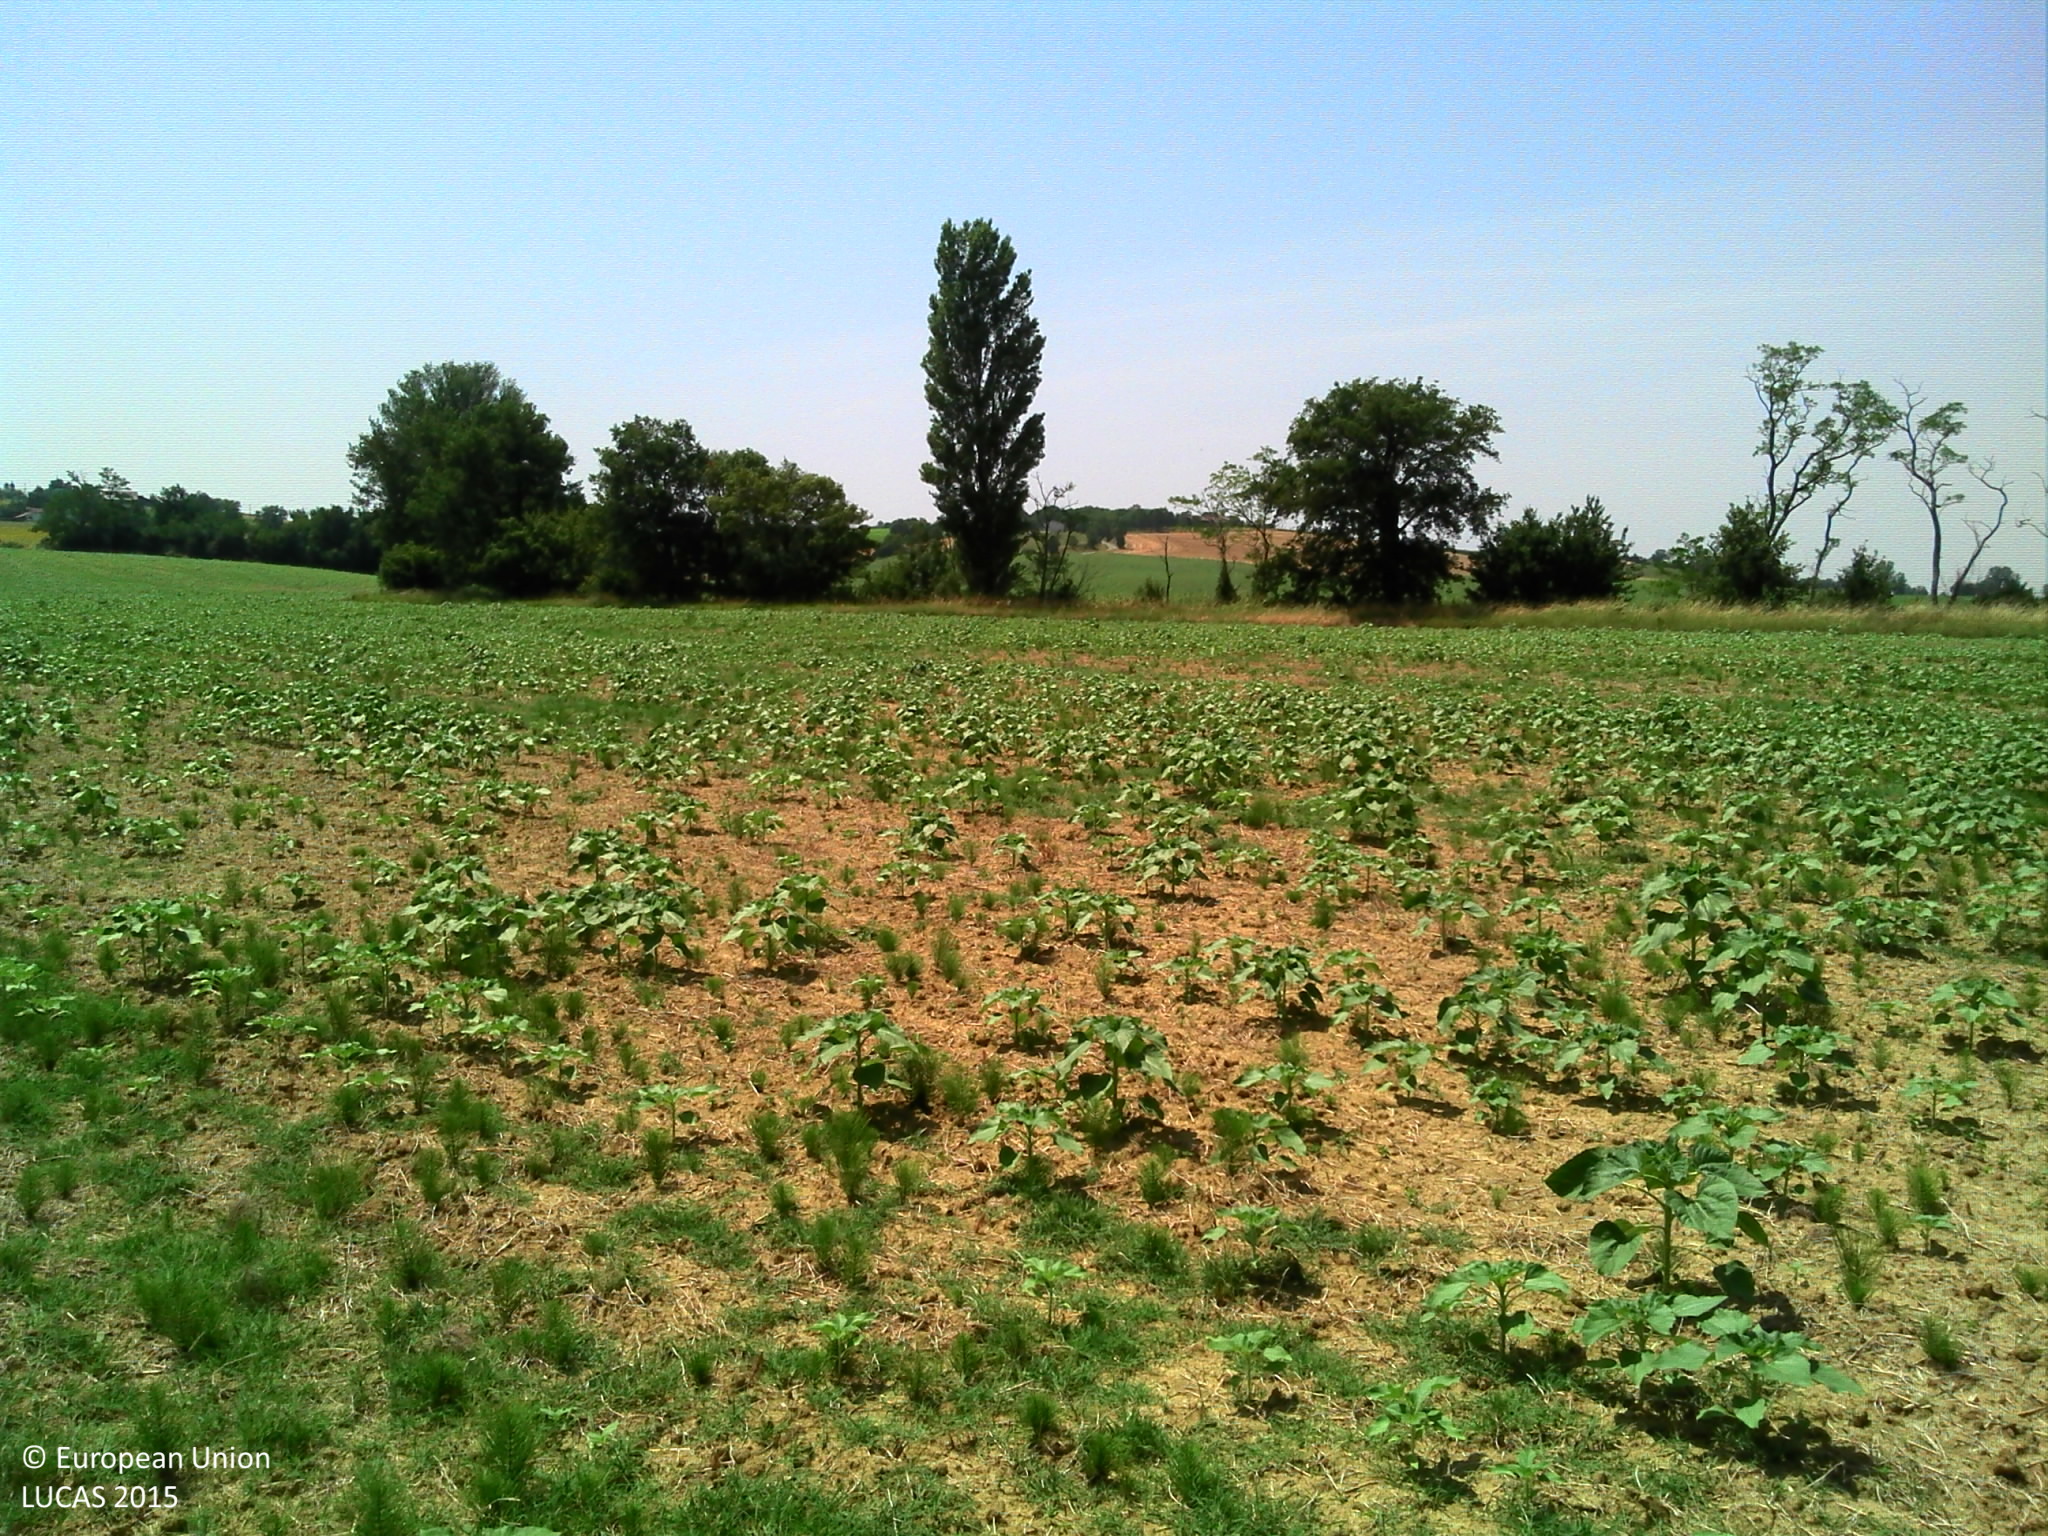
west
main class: Cropland
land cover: Sunflower
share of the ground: > 75 %
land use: Agriculture (excluding fallow land and kitchen gardens)
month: July
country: FR
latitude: 43.6040
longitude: 1.7406
